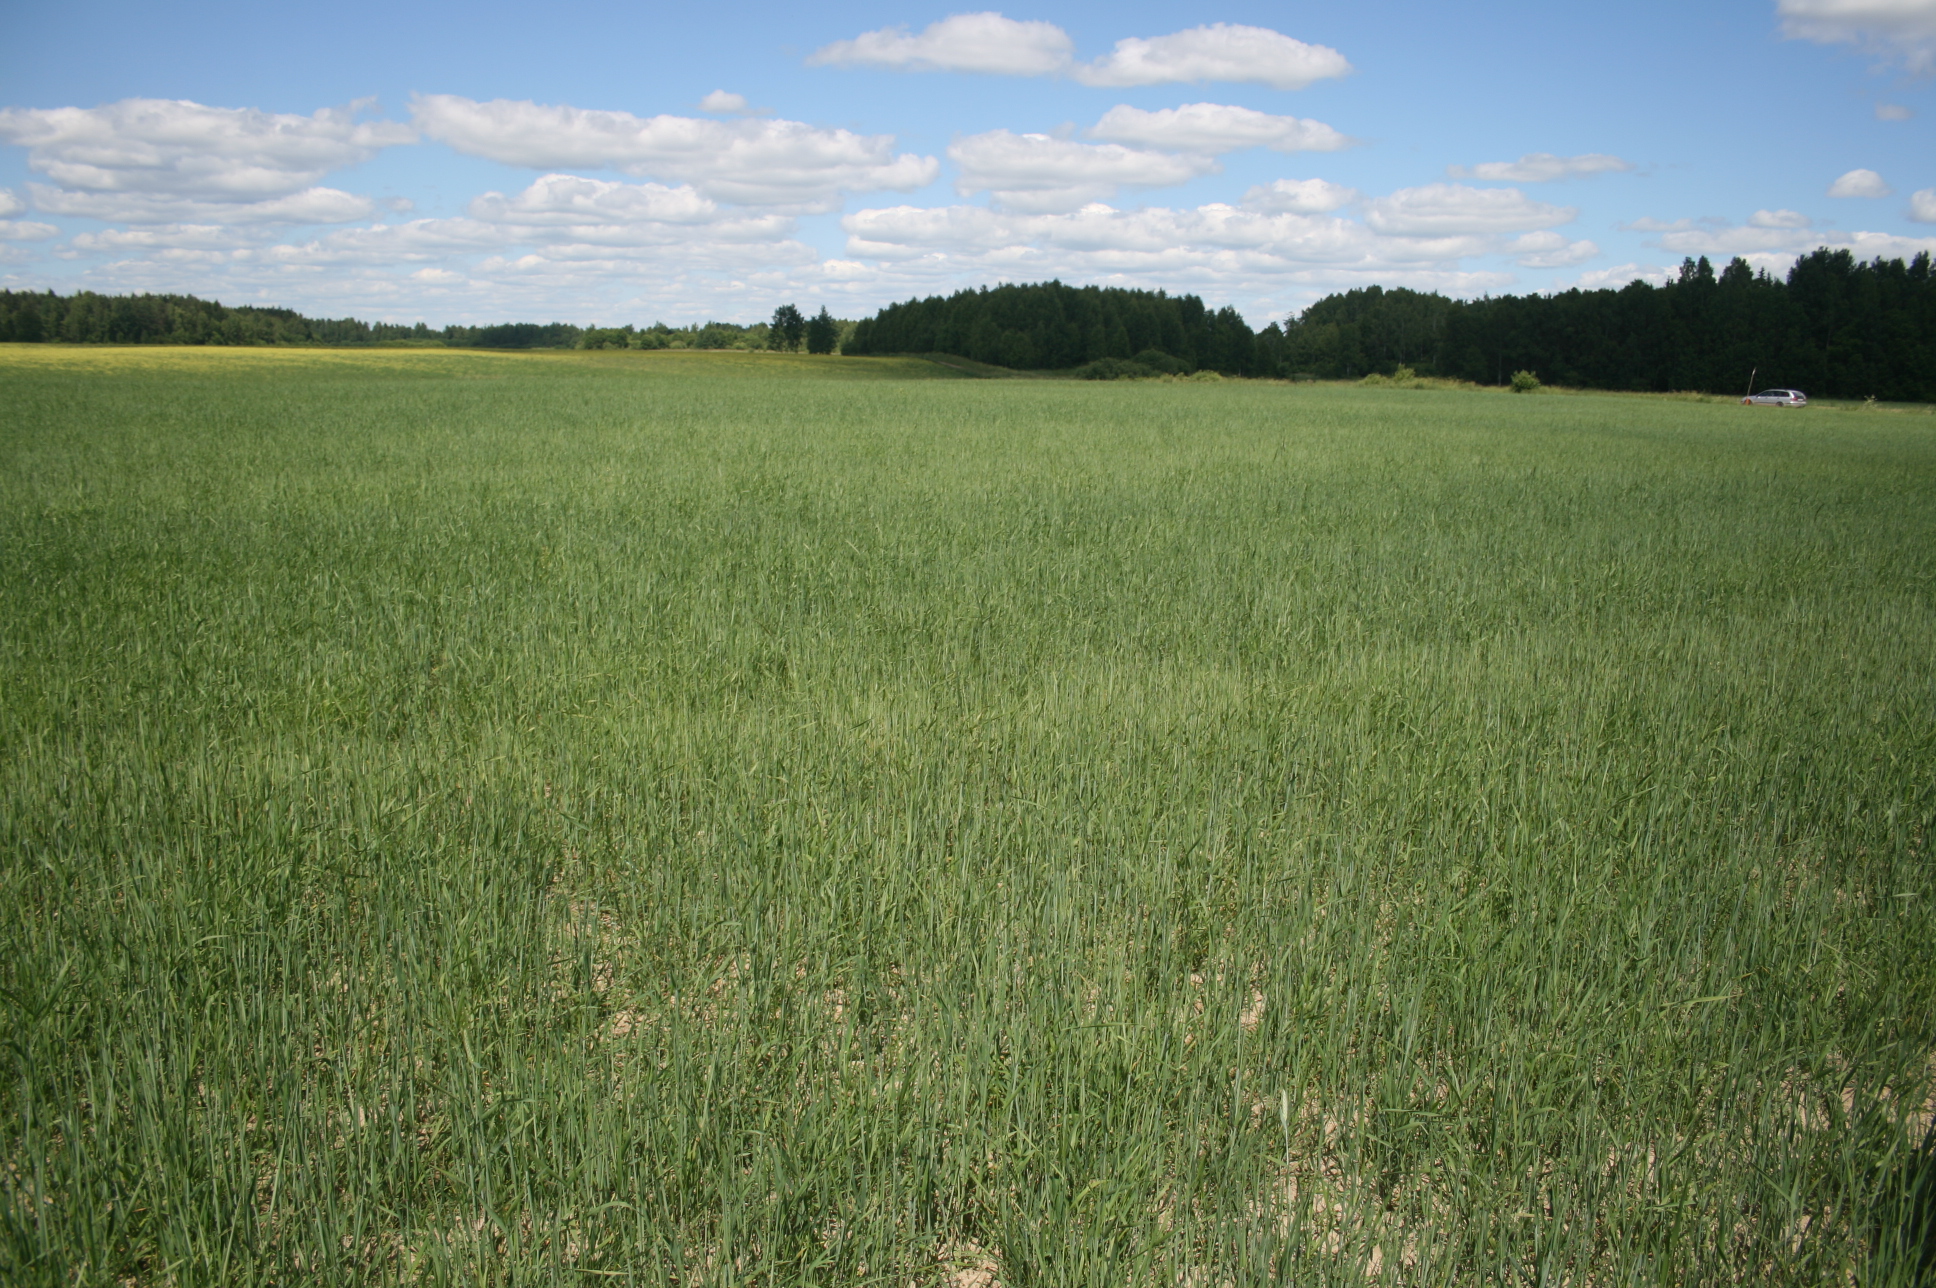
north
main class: Cropland
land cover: Barley
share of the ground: > 75 %
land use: Agriculture (excluding fallow land and kitchen gardens)
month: June
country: LT
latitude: 55.4294
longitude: 22.1123
